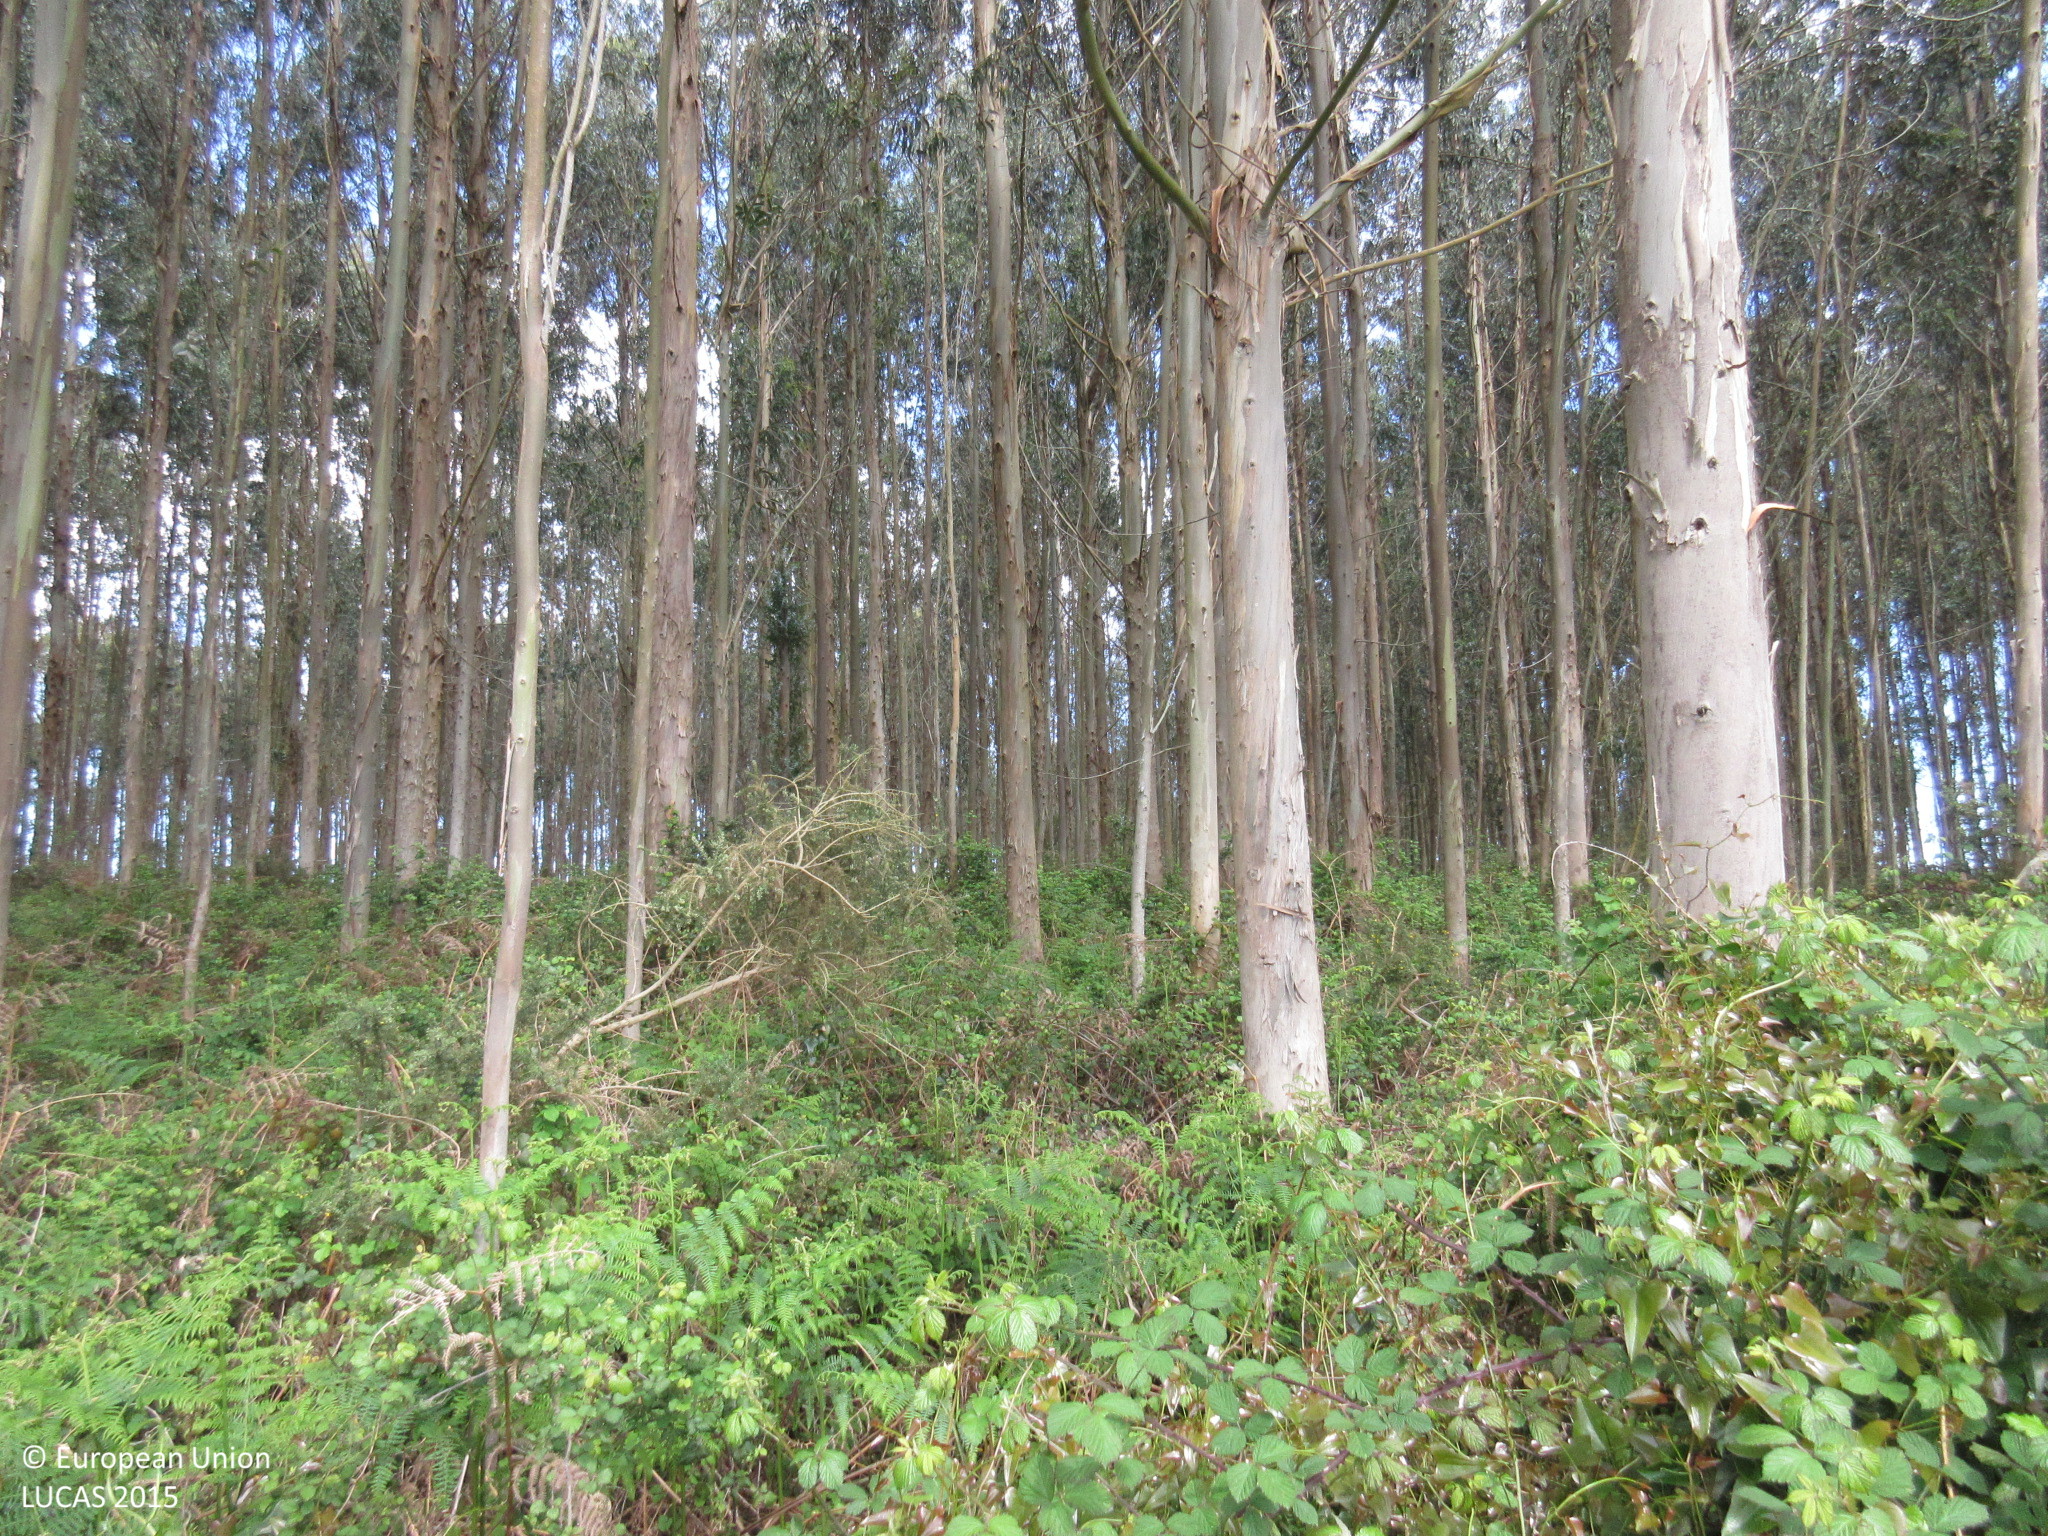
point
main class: Woodland
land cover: Broadleaved woodland
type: exotic forest
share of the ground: > 75 %
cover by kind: broadleaved forest trees 90 %, shrubs 10 %
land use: Forestry
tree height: > 5 m
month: April
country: ES
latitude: 43.4736
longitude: -5.1180
